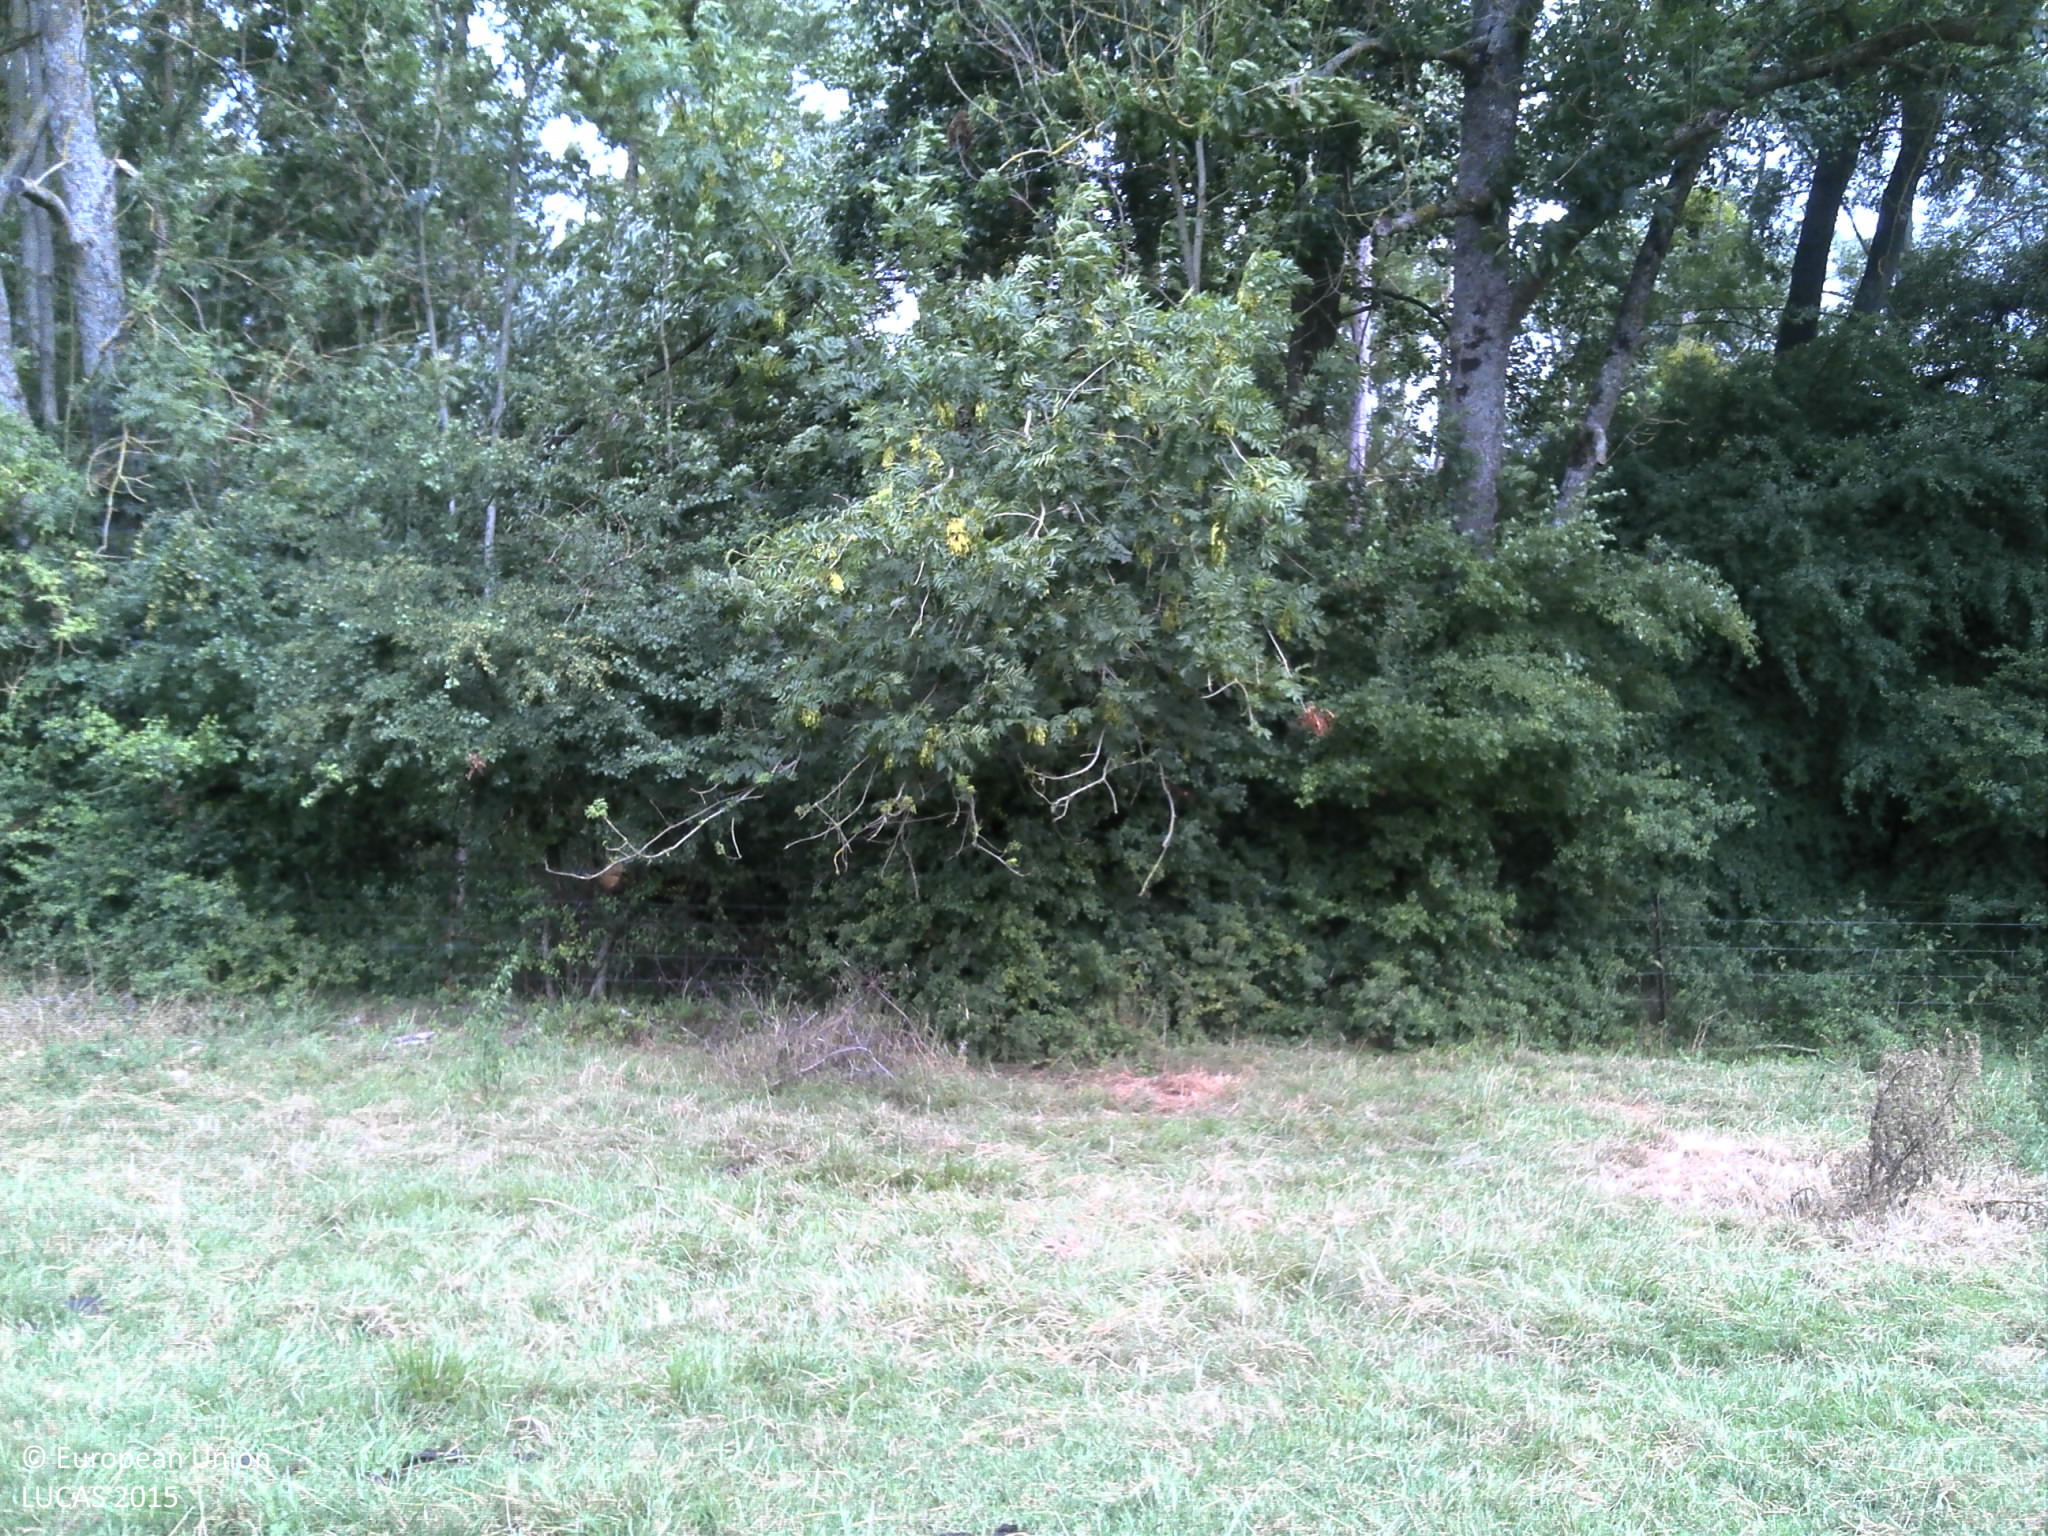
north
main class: Grassland
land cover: Grassland without tree/shrub cover
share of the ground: > 75 %
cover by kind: herbaceous plants 100 %
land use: Agriculture (excluding fallow land and kitchen gardens)
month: July
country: FR
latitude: 49.4104
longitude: 4.6628
